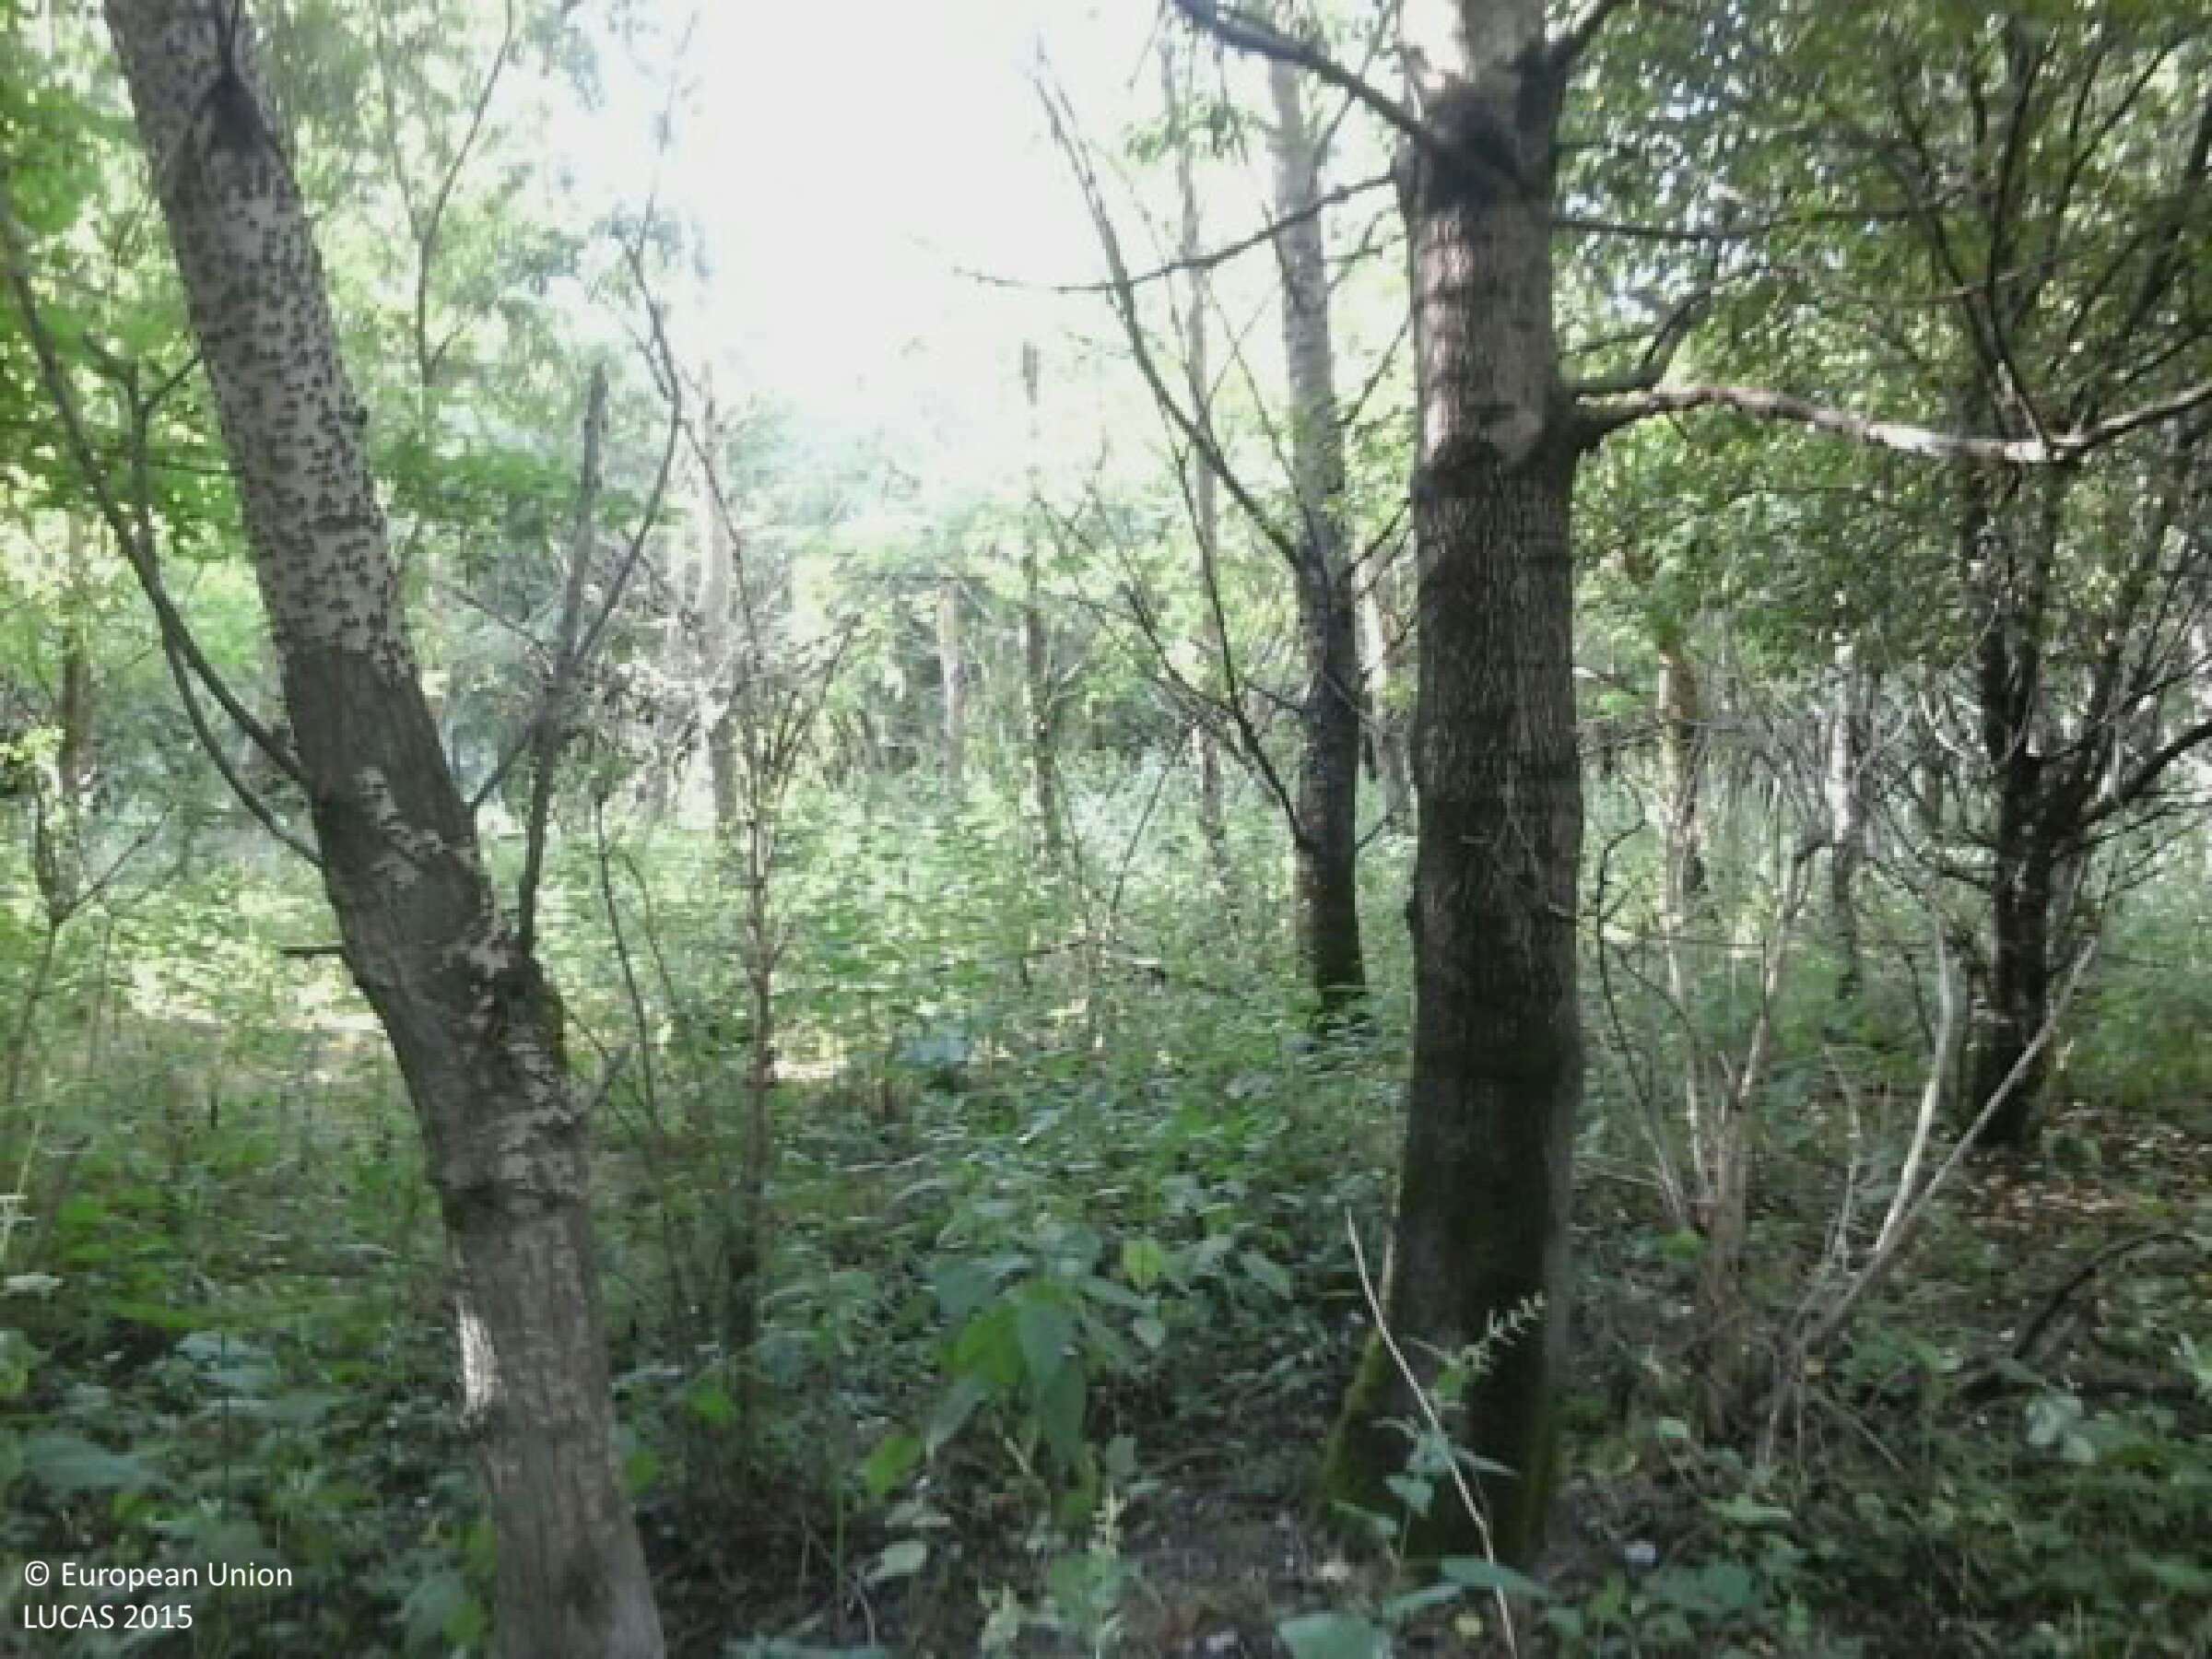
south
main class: Woodland
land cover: Broadleaved woodland
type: mesophytic deciduous forest
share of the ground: > 75 %
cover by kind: broadleaved forest trees 80 %, shrubs 10 %, herbaceous plants 10 %
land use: Forestry
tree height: > 5 m
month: July
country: HU
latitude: 46.3052
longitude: 18.9062
